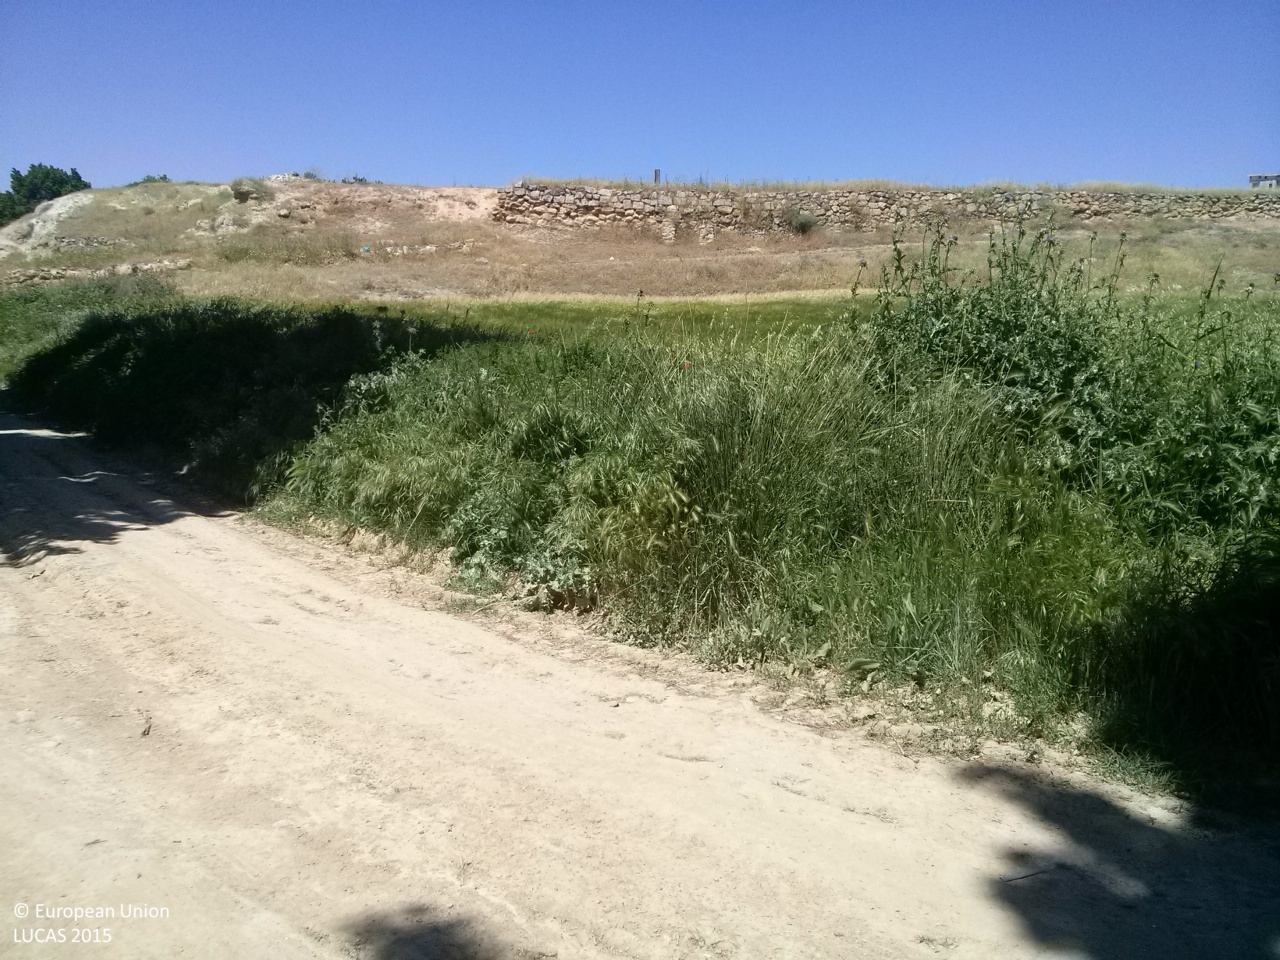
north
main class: Grassland
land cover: Grassland with sparse tree/shrub cover
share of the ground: 50 - 75 %
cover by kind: herbaceous plants 60 %, unconsolidated bare surface 35 %, broadleaved forest trees 5 %
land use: Abandoned areas
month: May
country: ES
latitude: 40.3639
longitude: -2.7553
